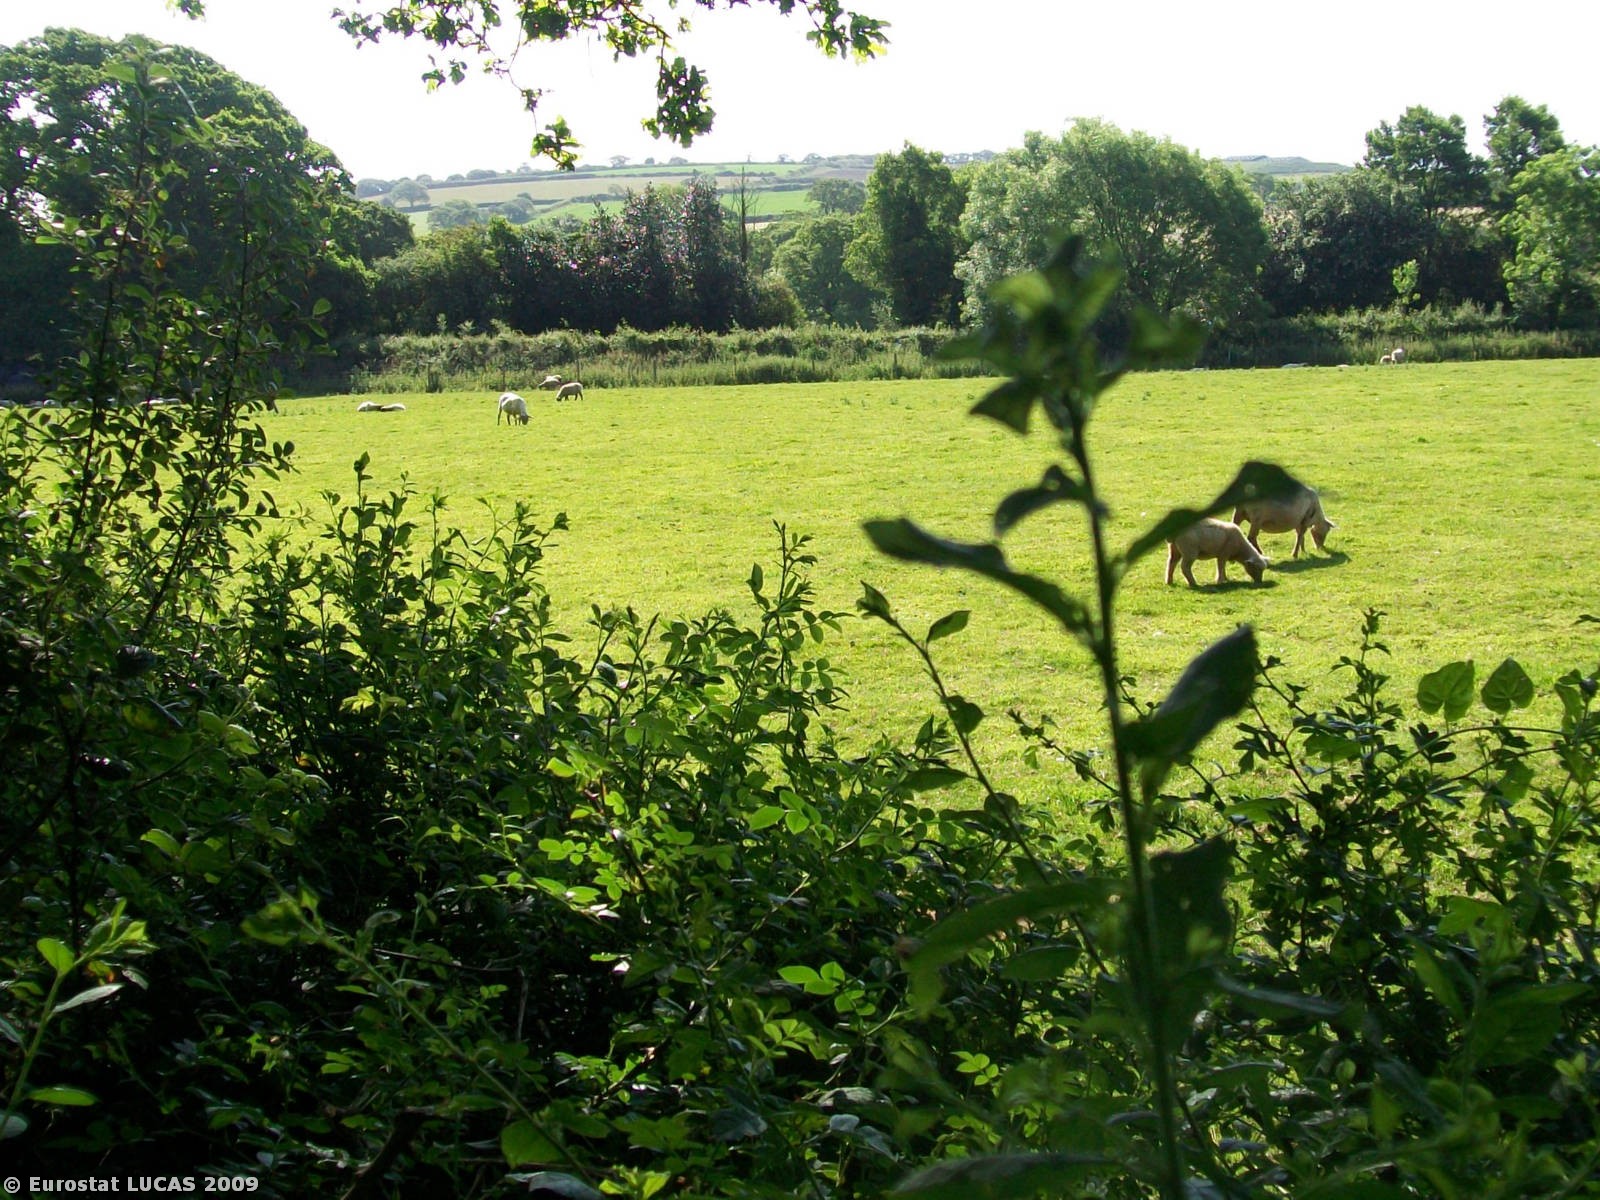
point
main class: Grassland
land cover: Grassland without tree/shrub cover
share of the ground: > 75 %
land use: Agriculture (excluding fallow land and kitchen gardens)
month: June
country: GB
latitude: 50.1791
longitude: -5.0870
